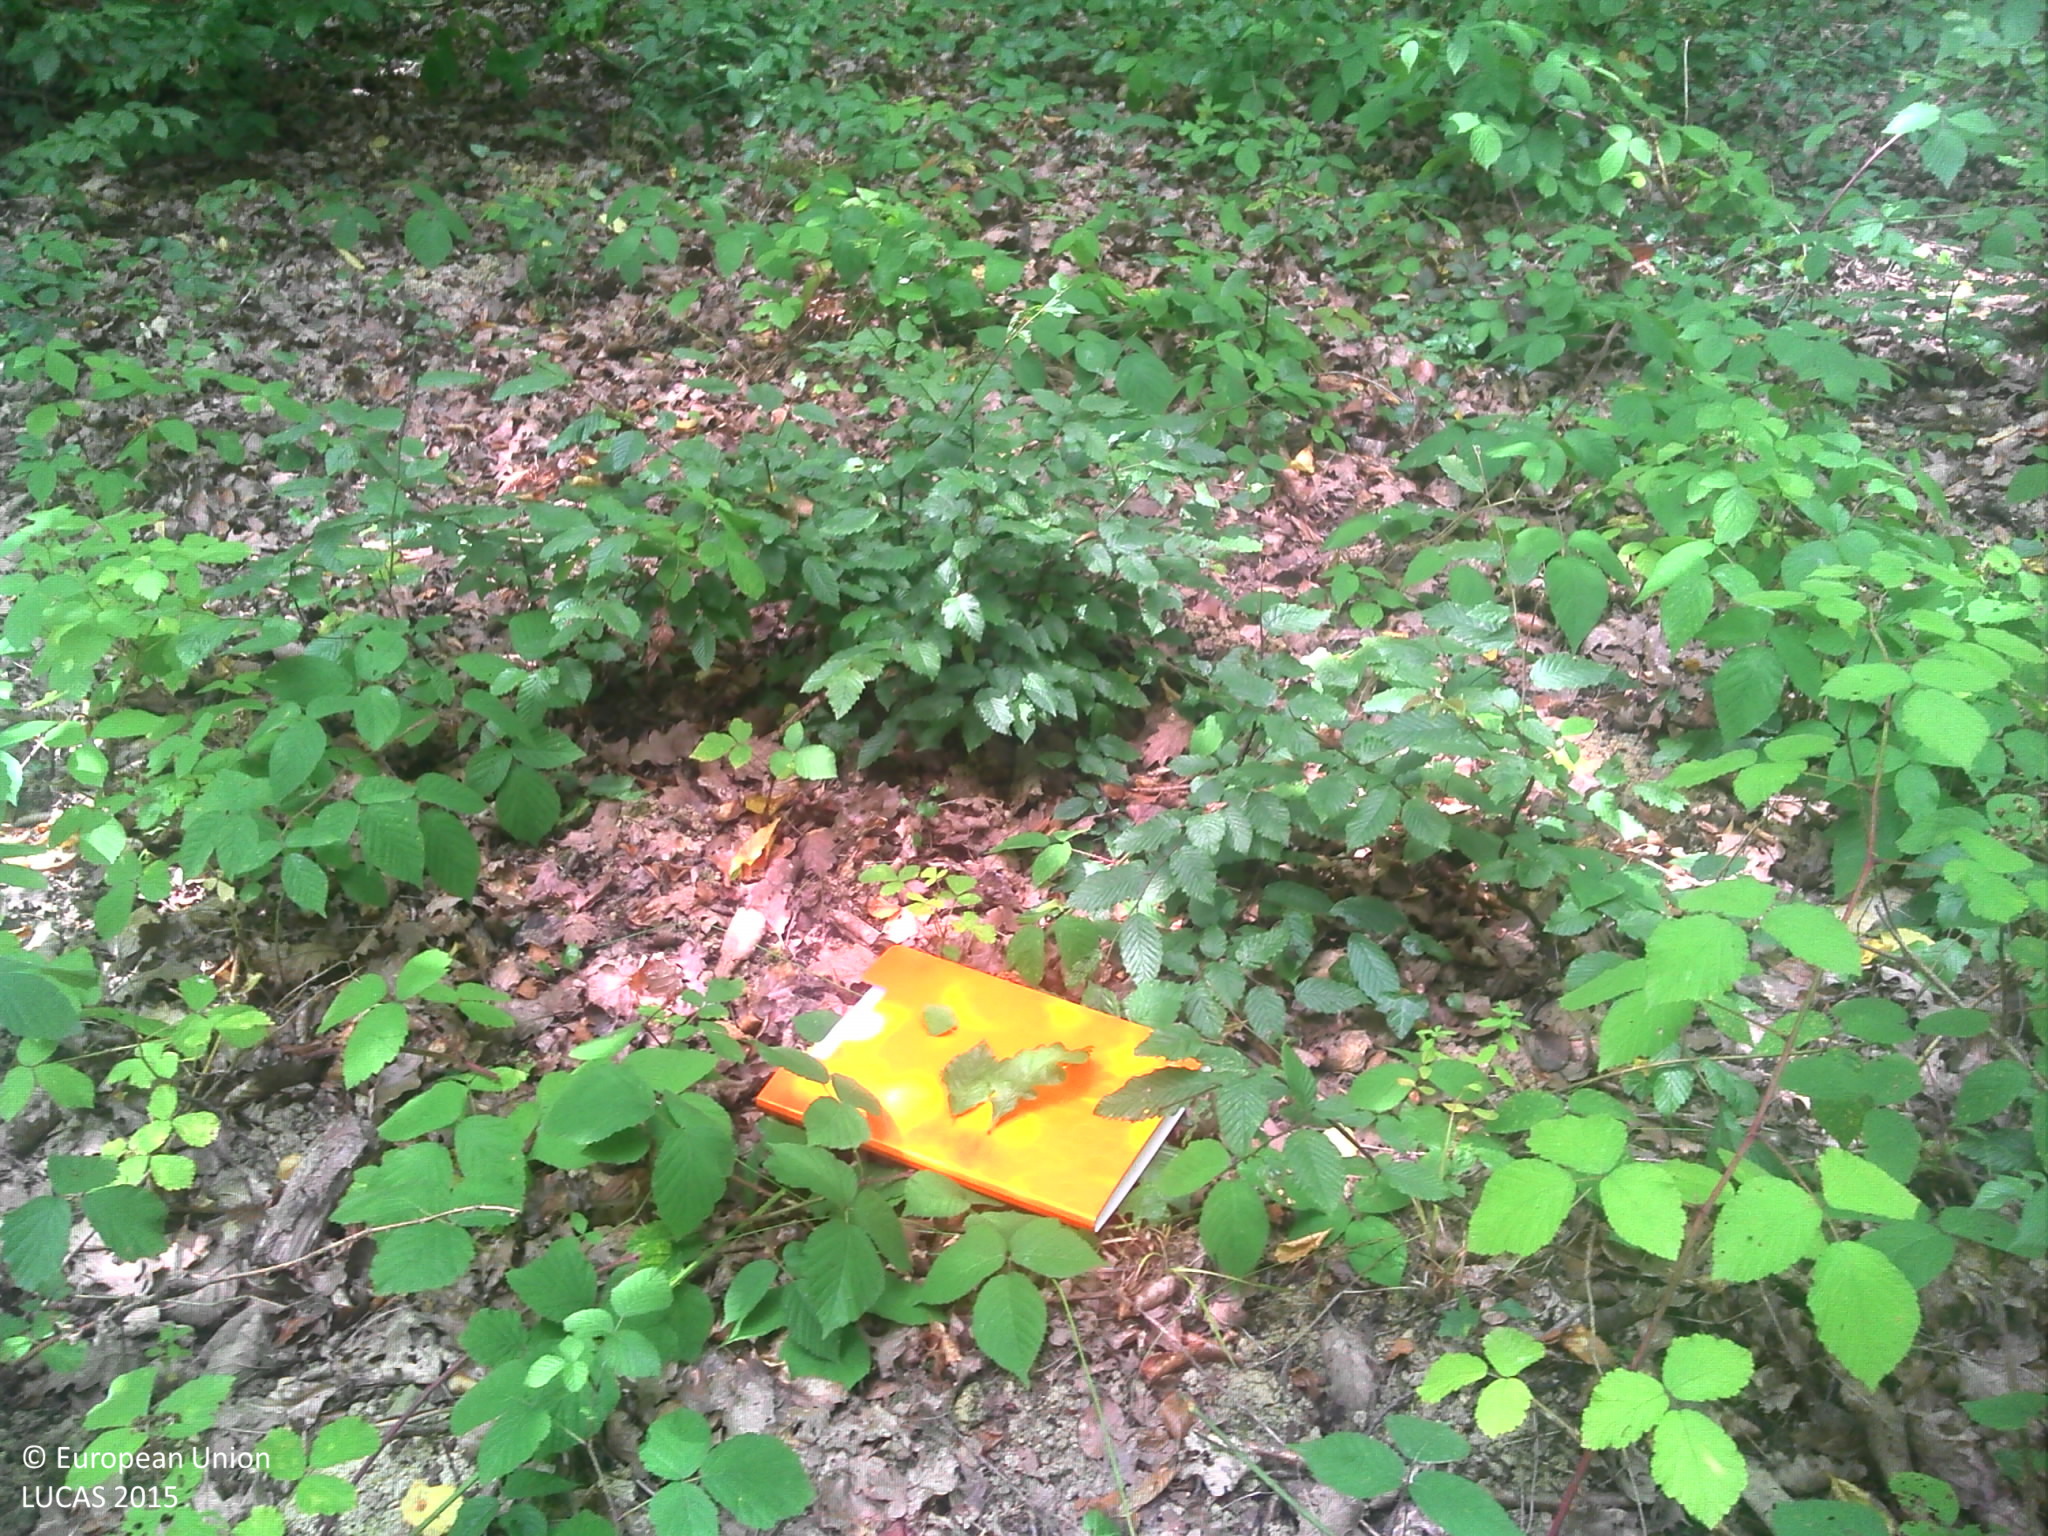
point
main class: Woodland
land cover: Broadleaved woodland
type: mesophytic deciduous forest
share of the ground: > 75 %
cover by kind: broadleaved forest trees 70 %, herbaceous plants 20 %, coniferous forest trees 5 %, lichens and mosses 5 %
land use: Forestry
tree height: > 5 m
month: July
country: FR
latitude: 47.7433
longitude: 5.2655
